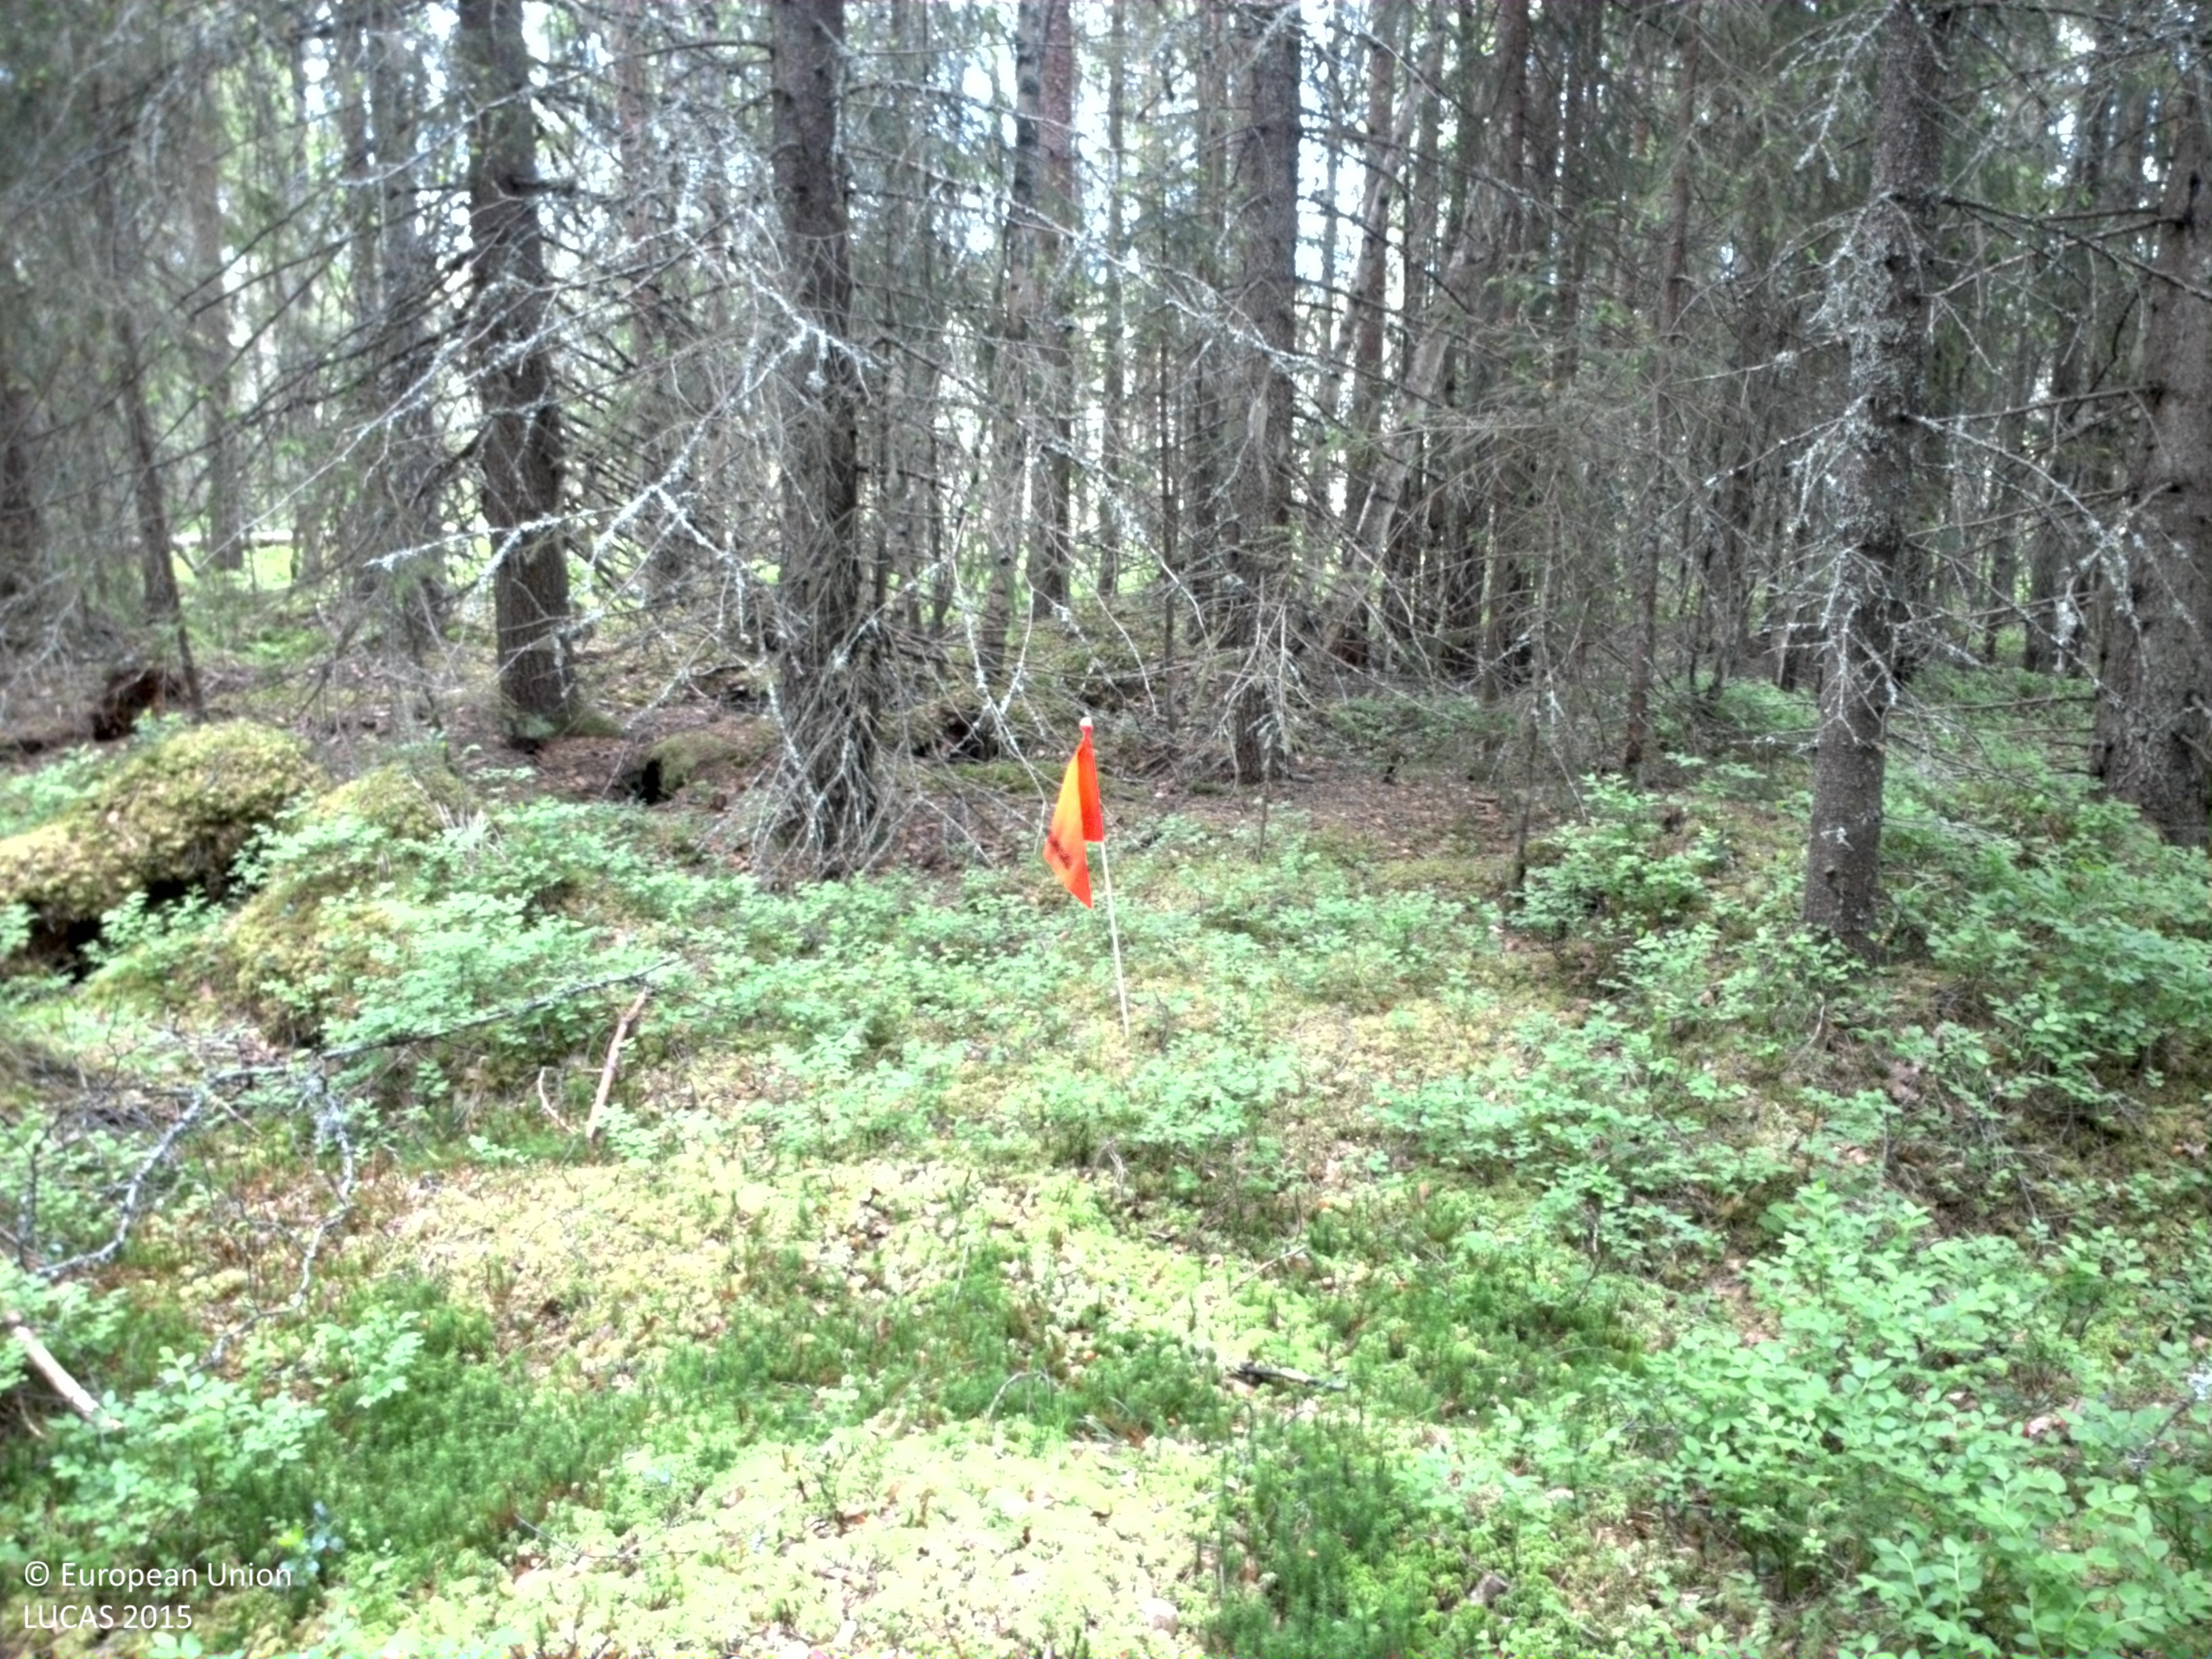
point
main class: Woodland
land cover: Spruce dominated coniferous woodland
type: boreal forest
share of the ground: > 75 %
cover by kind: coniferous forest trees 75 %, broadleaved forest trees 15 %, lichens and mosses 10 %
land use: Forestry
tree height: > 5 m
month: June
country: SE
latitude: 61.1278
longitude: 13.5341
